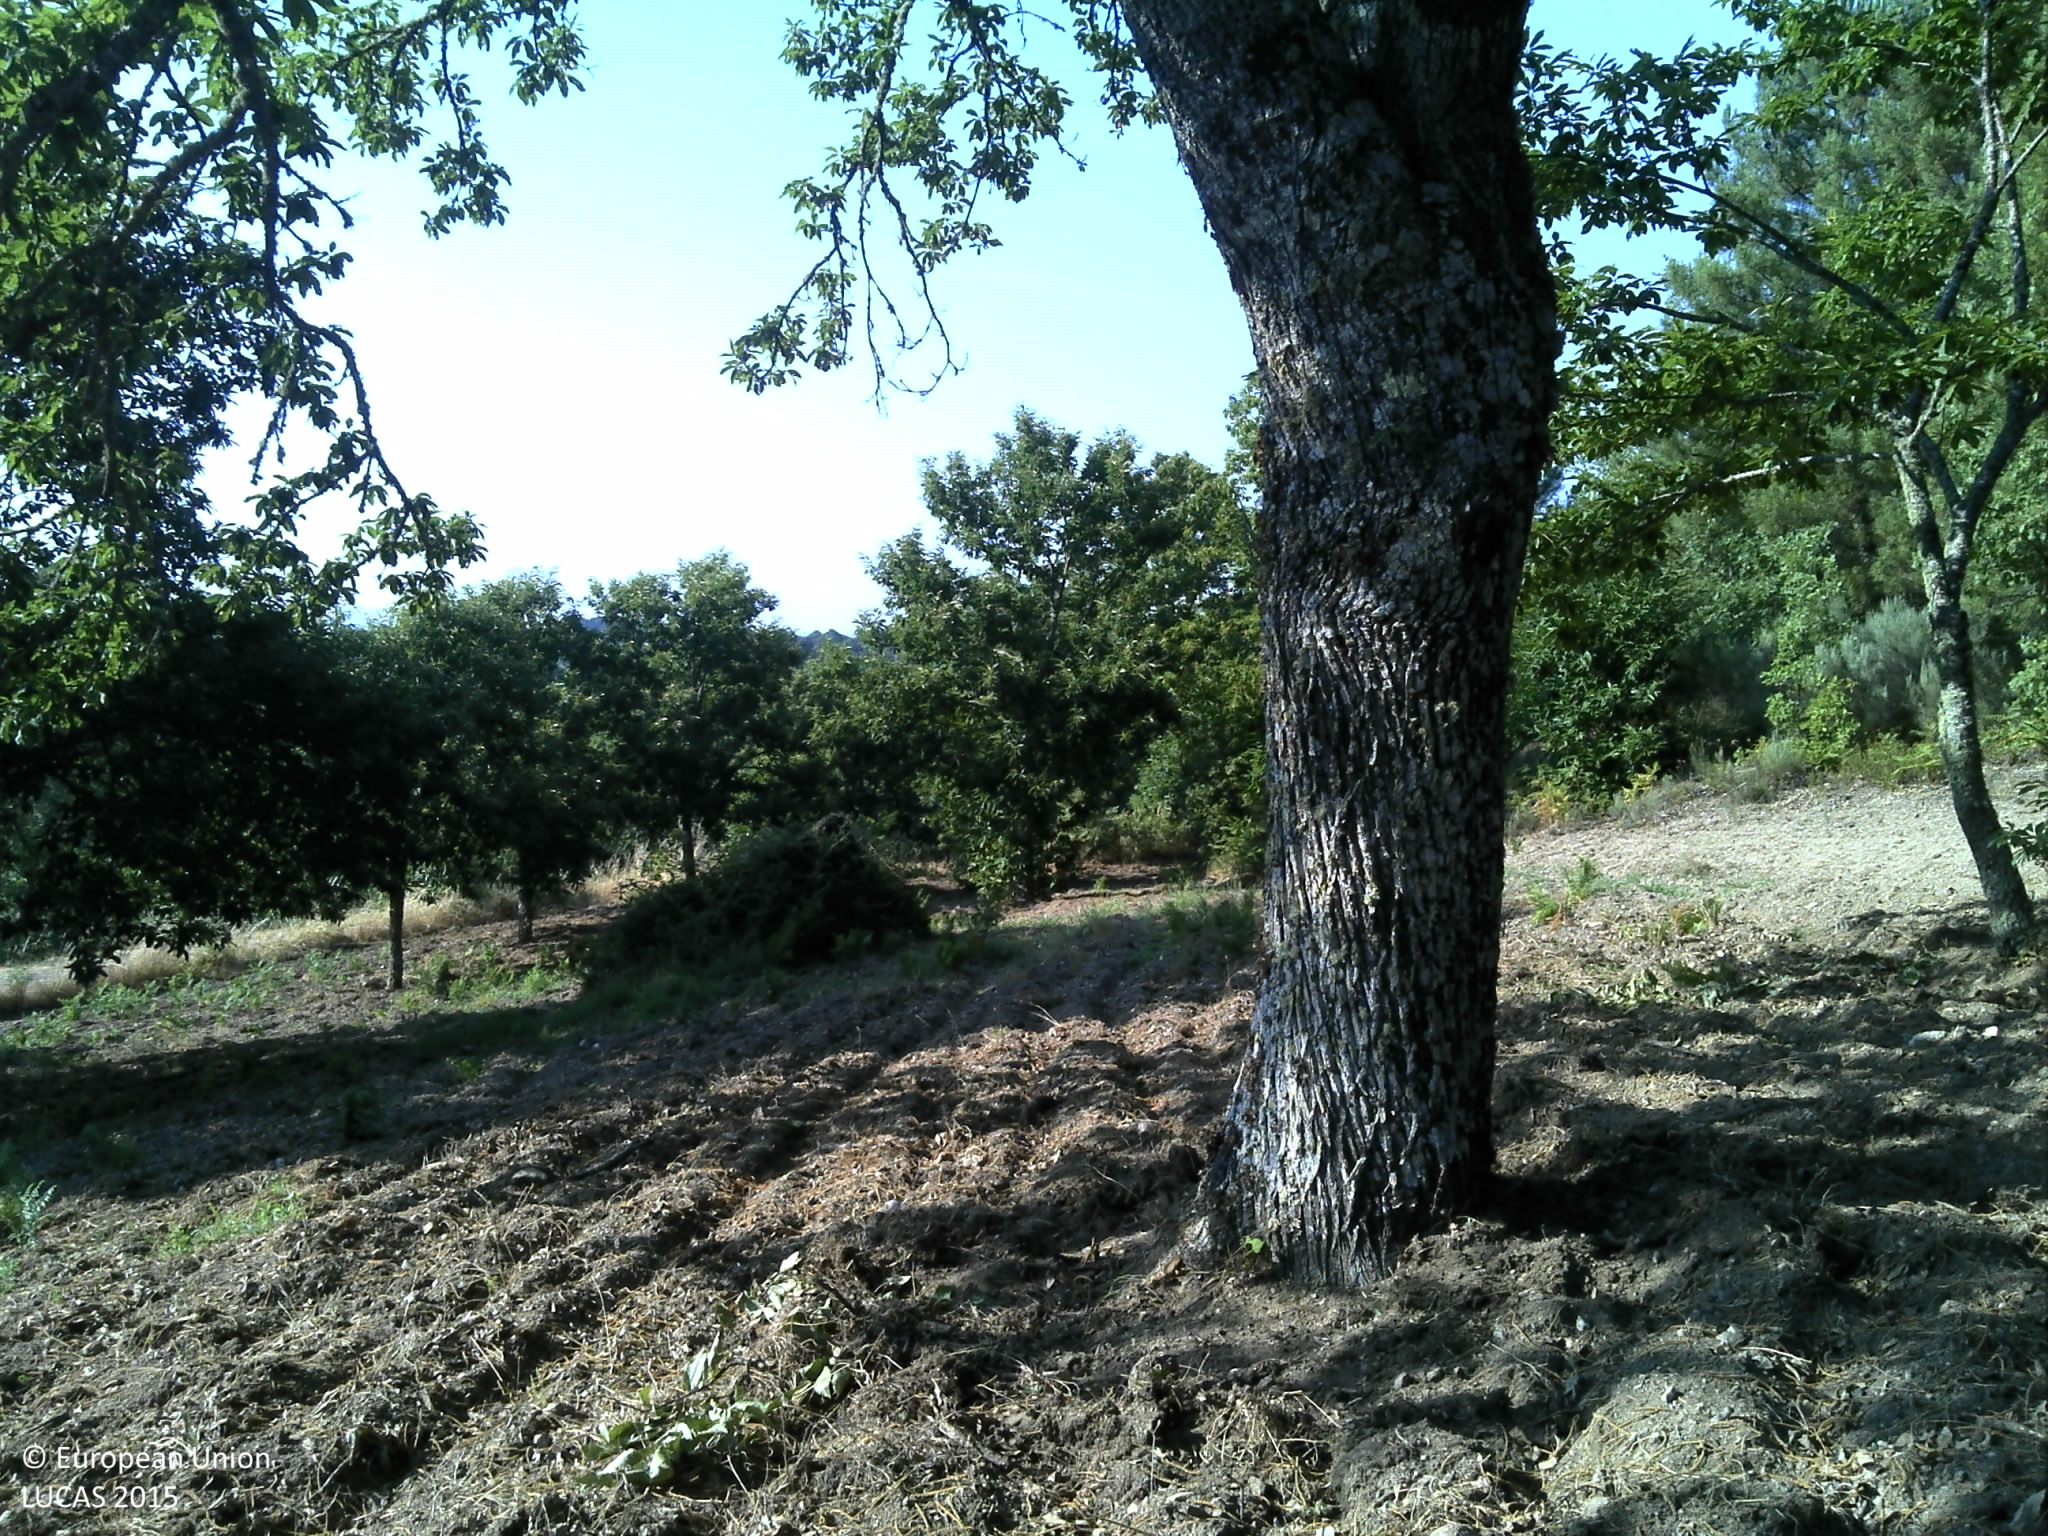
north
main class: Cropland
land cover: Nuts trees
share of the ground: 25 - 50 %
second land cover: Spontaneously vegetated surfaces
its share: 10 - 25 %
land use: Agriculture (excluding fallow land and kitchen gardens)
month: July
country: PT
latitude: 40.8939
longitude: -7.5065
